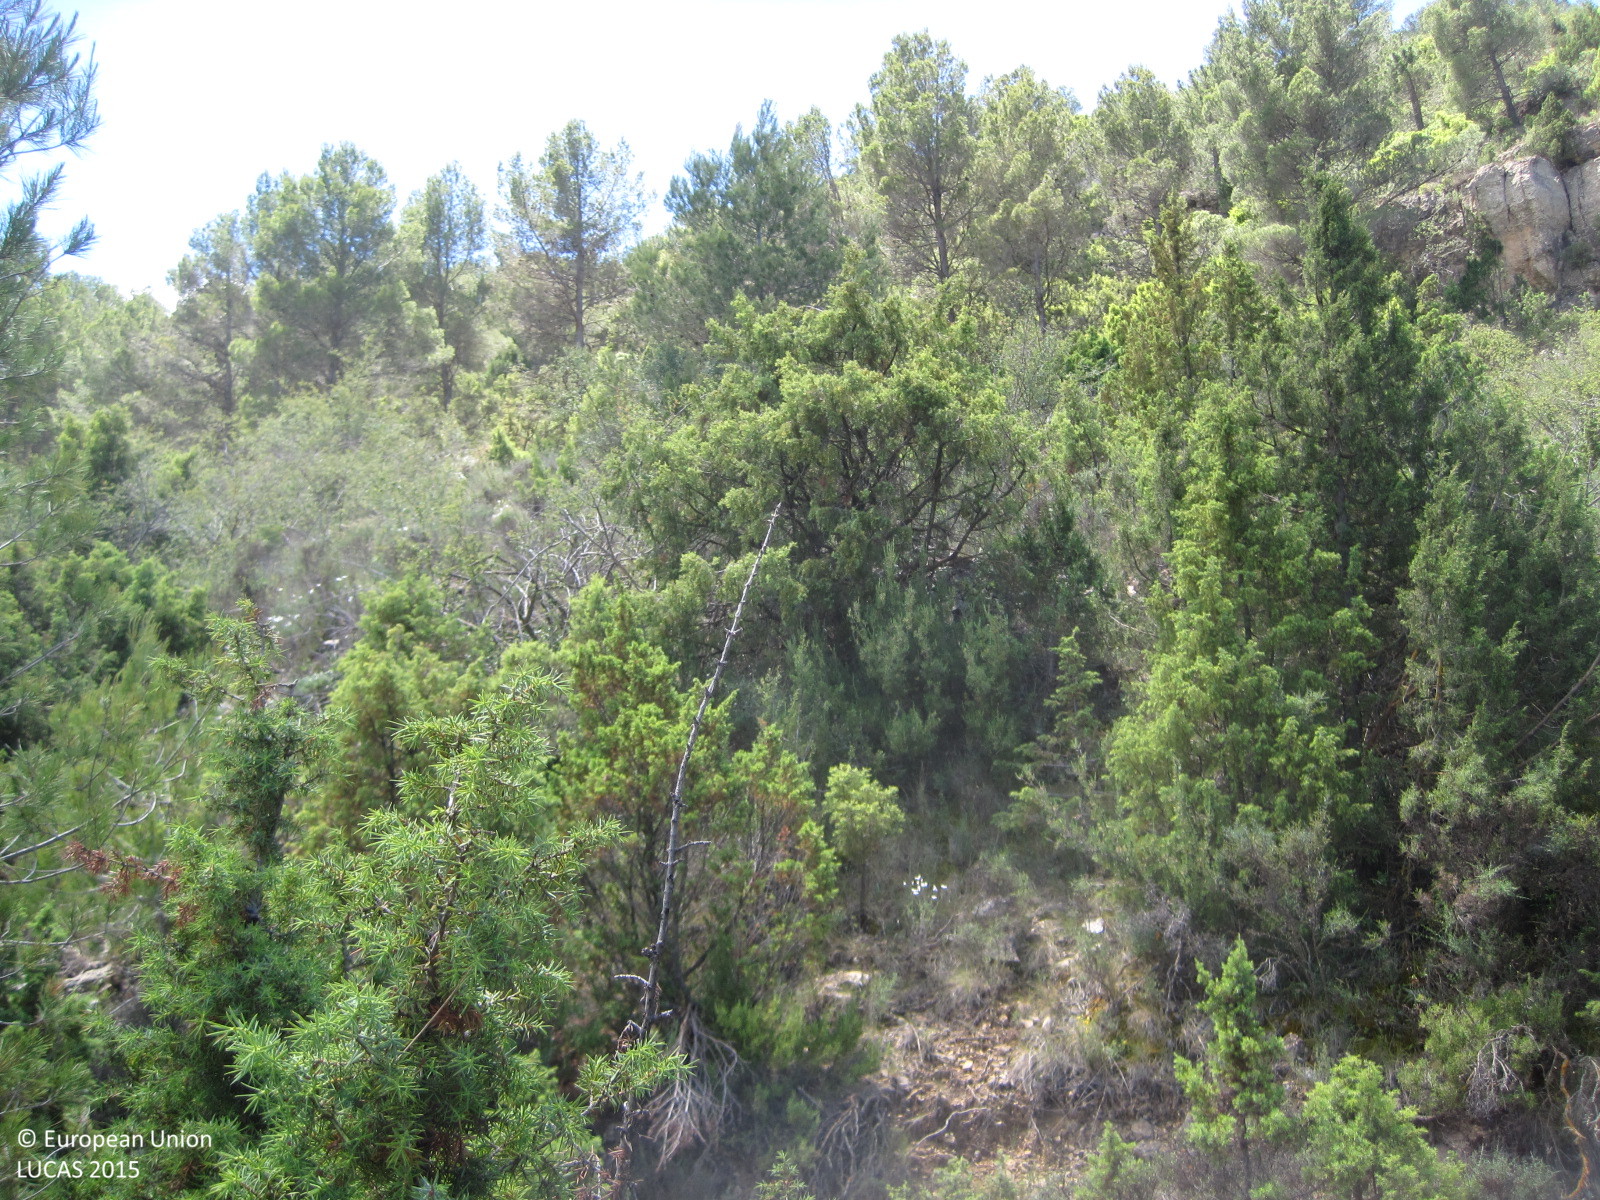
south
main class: Woodland
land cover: Broadleaved woodland
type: acidophilous oak and oak-birch forest
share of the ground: 10 - 25 %
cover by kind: broadleaved forest trees 30 %, shrubs 30 %, consolidated bare surface 25 %, herbaceous plants 10 %, coniferous forest trees 5 %
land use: Forestry
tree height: < 5 m
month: June
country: ES
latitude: 39.8678
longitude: -0.9824
